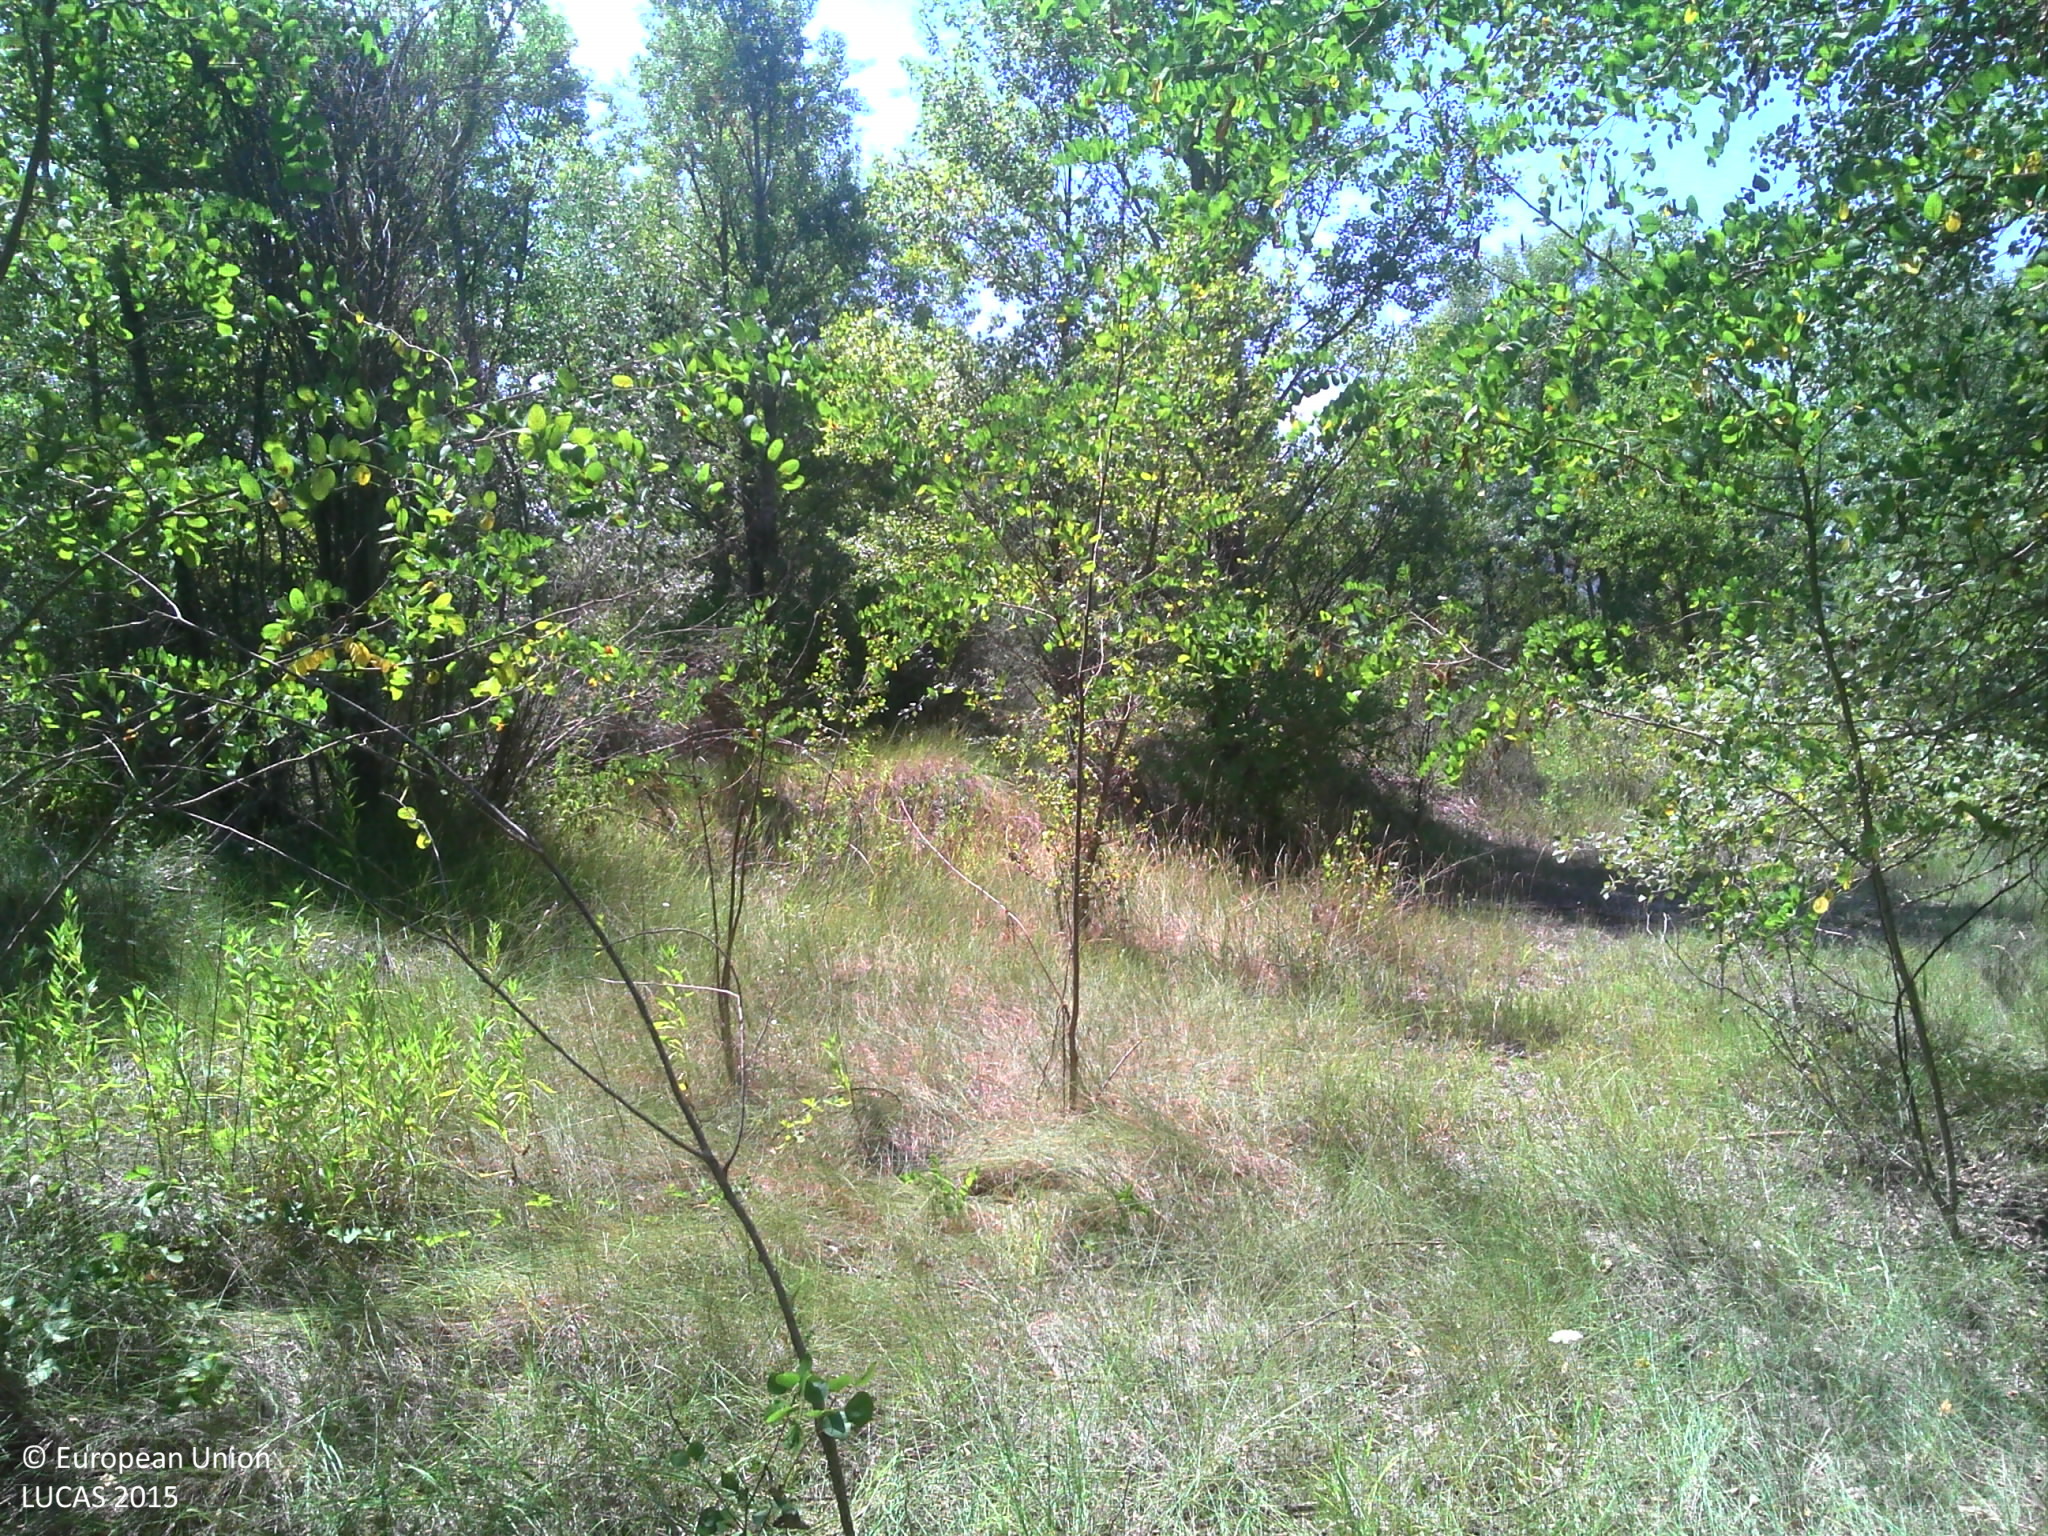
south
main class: Woodland
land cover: Broadleaved woodland
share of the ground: > 75 %
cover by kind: herbaceous plants 55 %, broadleaved forest trees 40 %, consolidated bare surface 5 %
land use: Semi-natural and natural areas not in use
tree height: > 5 m
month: August
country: FR
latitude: 43.7026
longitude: 5.7278
